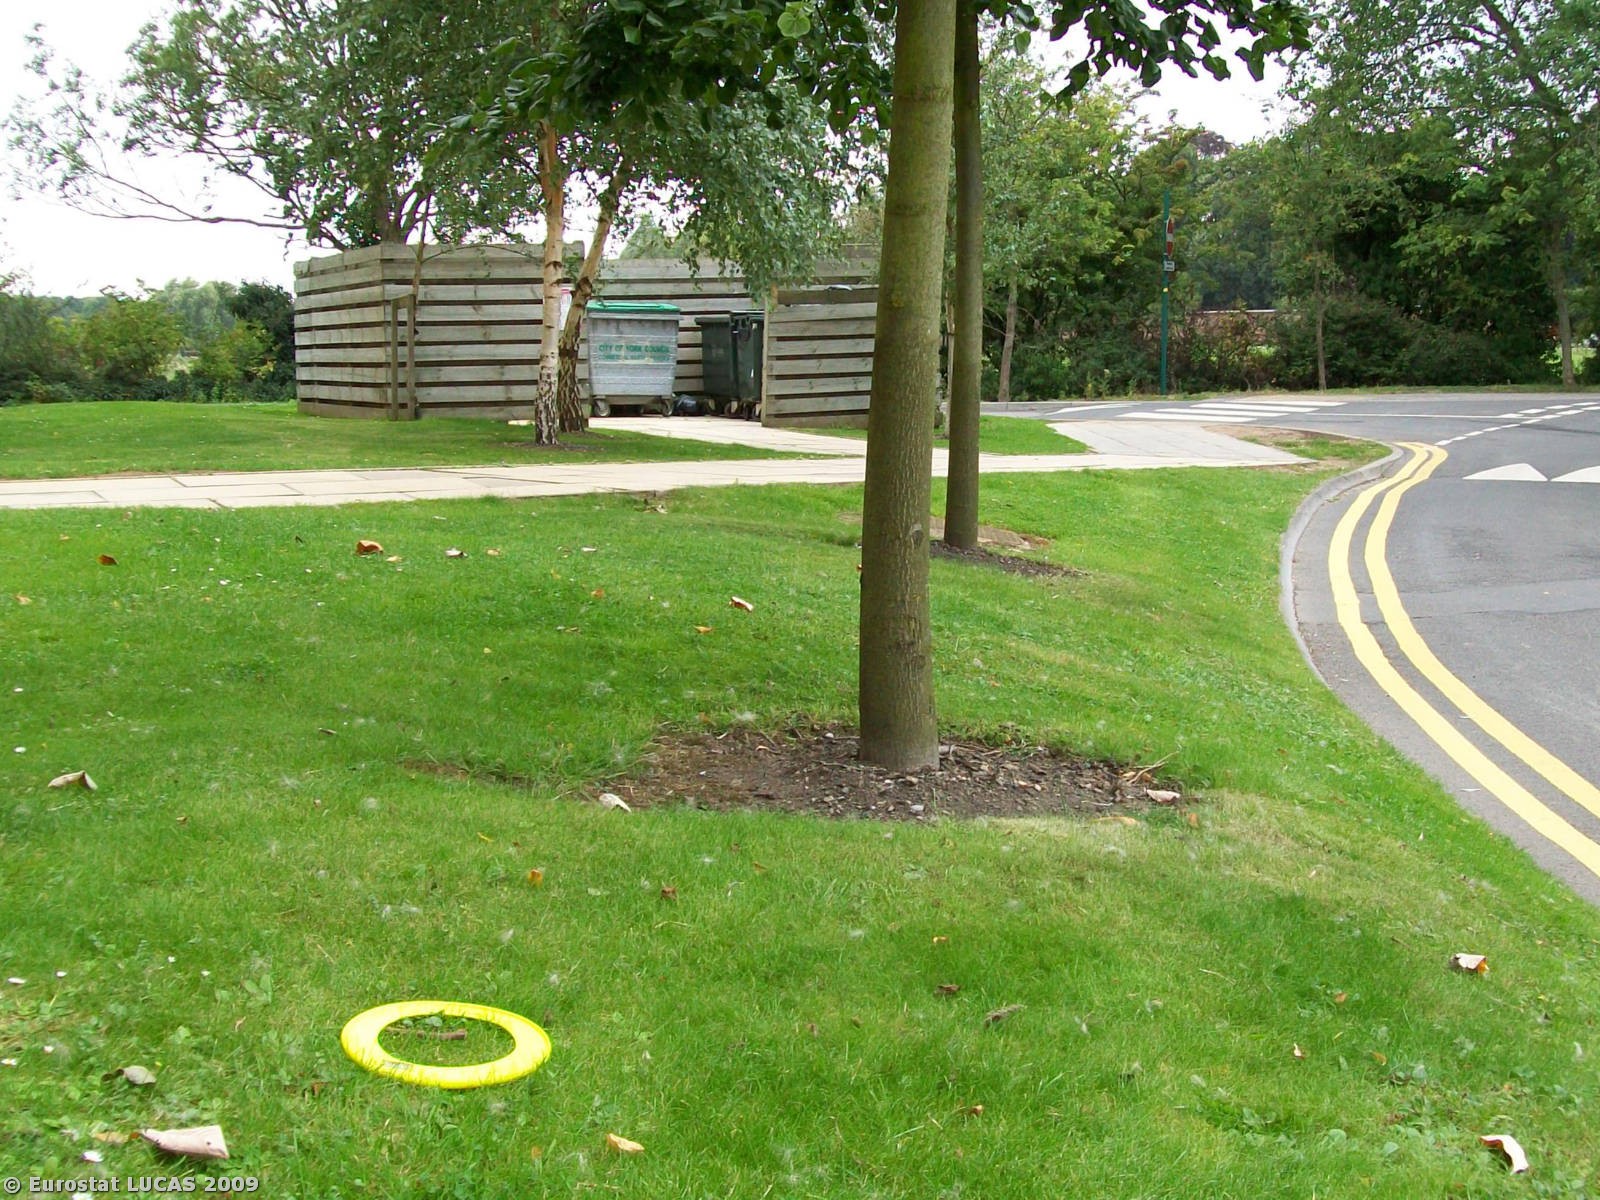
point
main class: Artificial land
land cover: Non built-up linear features
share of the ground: > 75 %
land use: Road transport
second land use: Community services
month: August
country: GB
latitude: 53.9466
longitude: -1.0592
